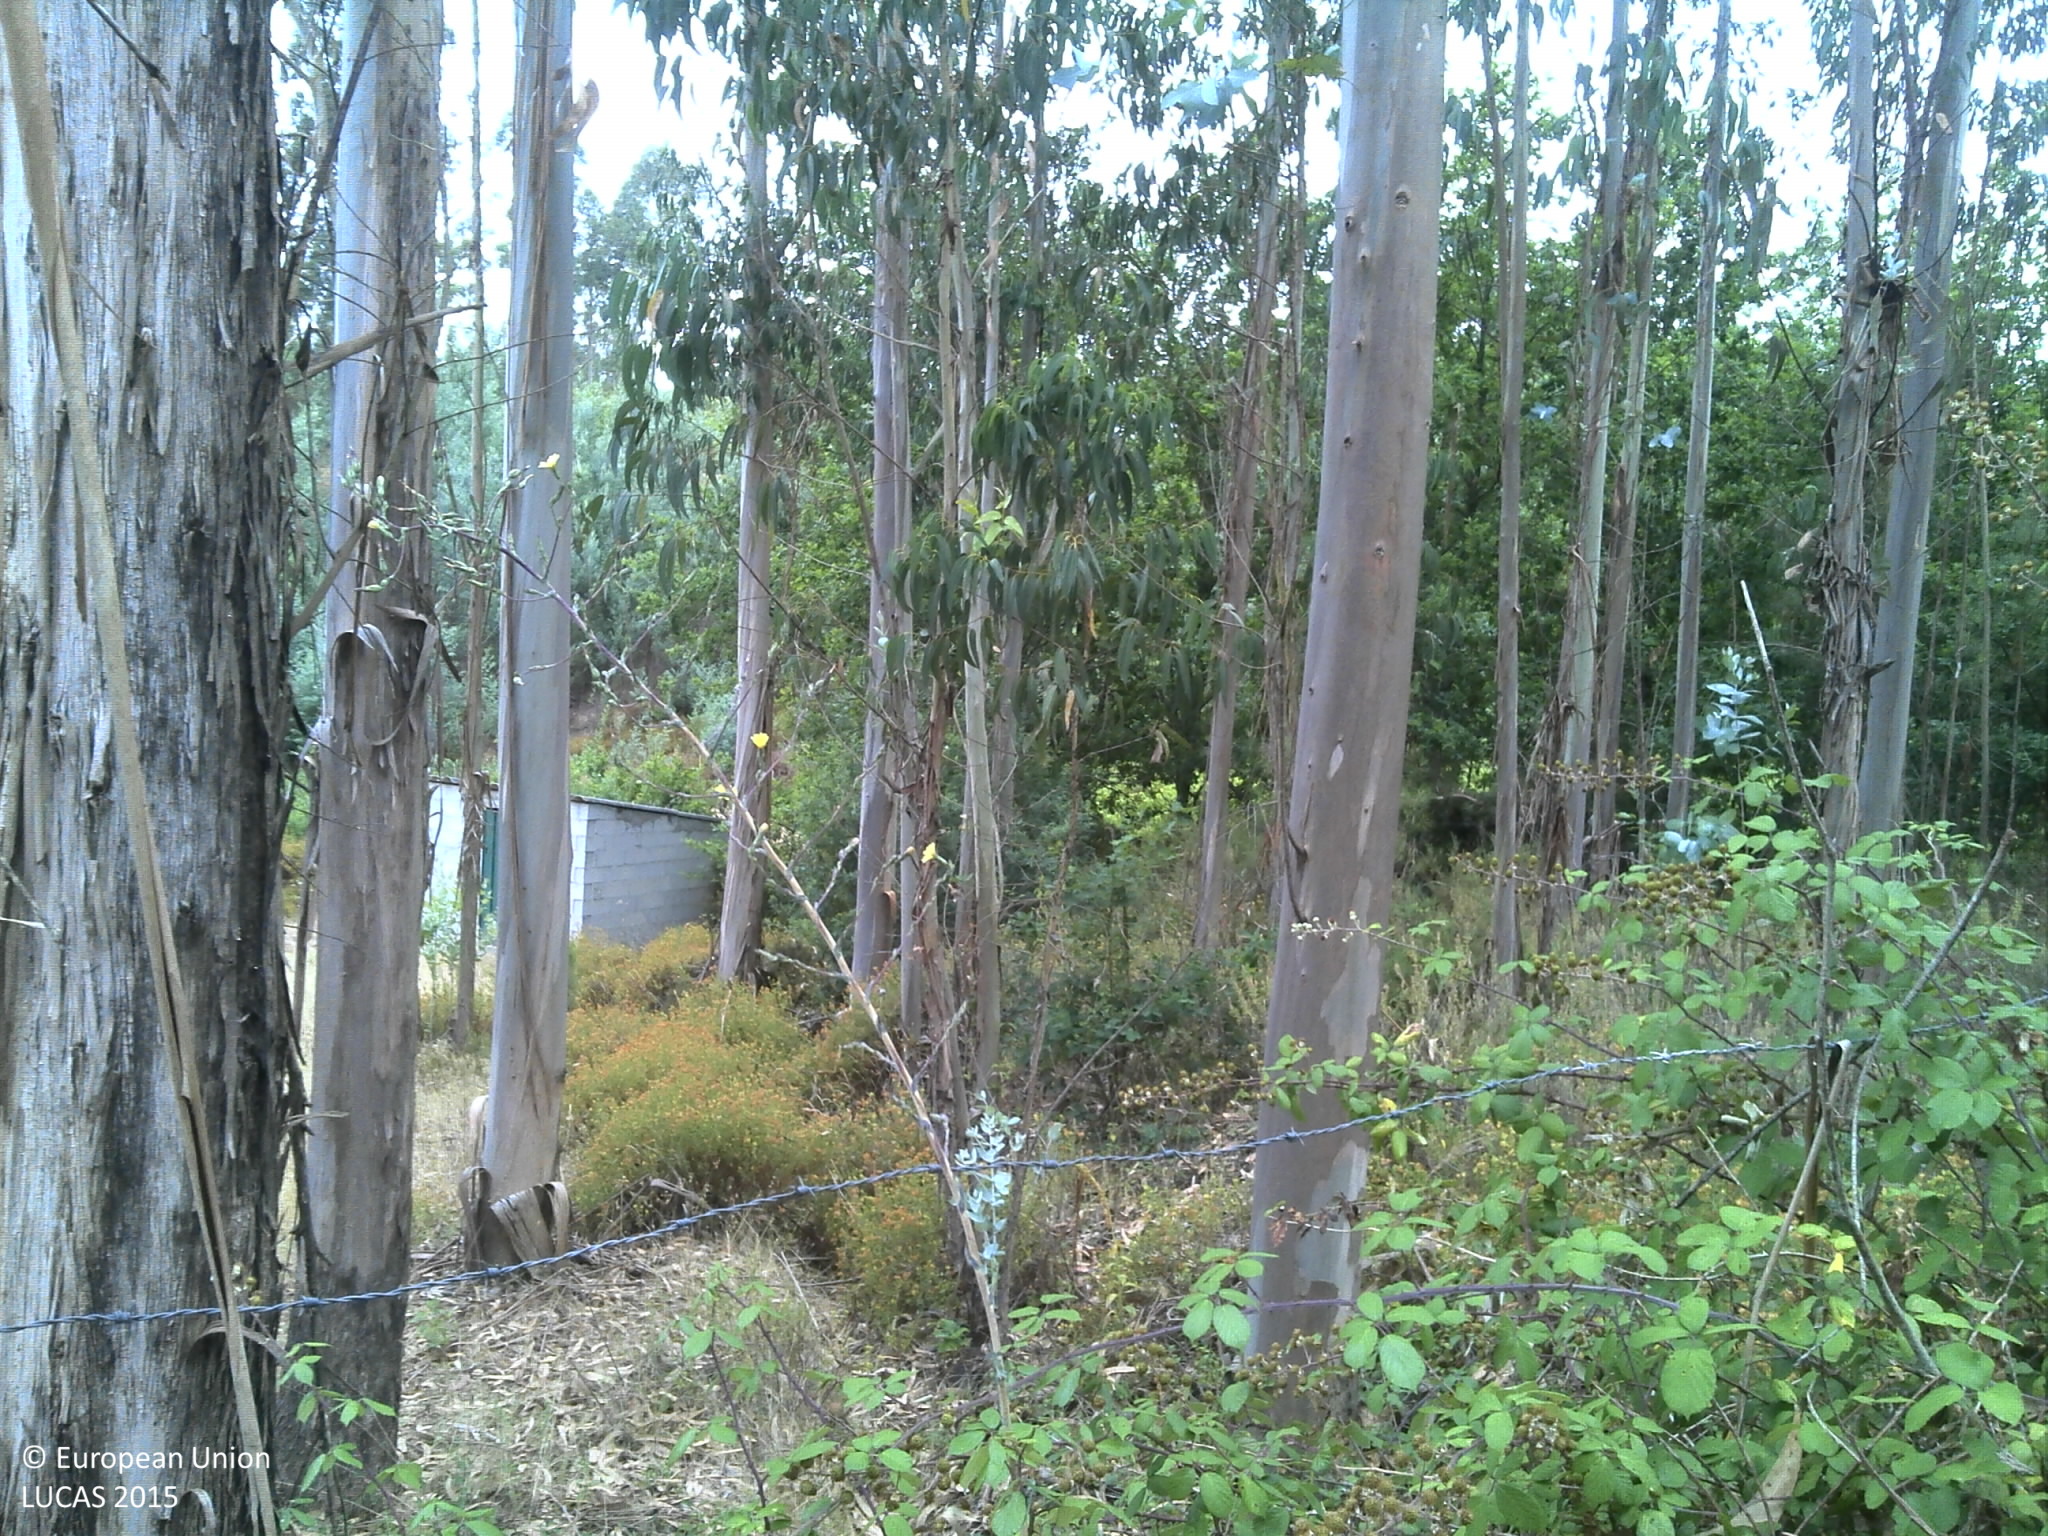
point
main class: Woodland
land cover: Broadleaved woodland
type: exotic forest
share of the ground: 50 - 75 %
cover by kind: broadleaved forest trees 70 %, shrubs 20 %, herbaceous plants 5 %, unconsolidated bare surface 5 %
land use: Forestry
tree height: > 5 m
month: July
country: PT
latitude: 40.3120
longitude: -8.2607
